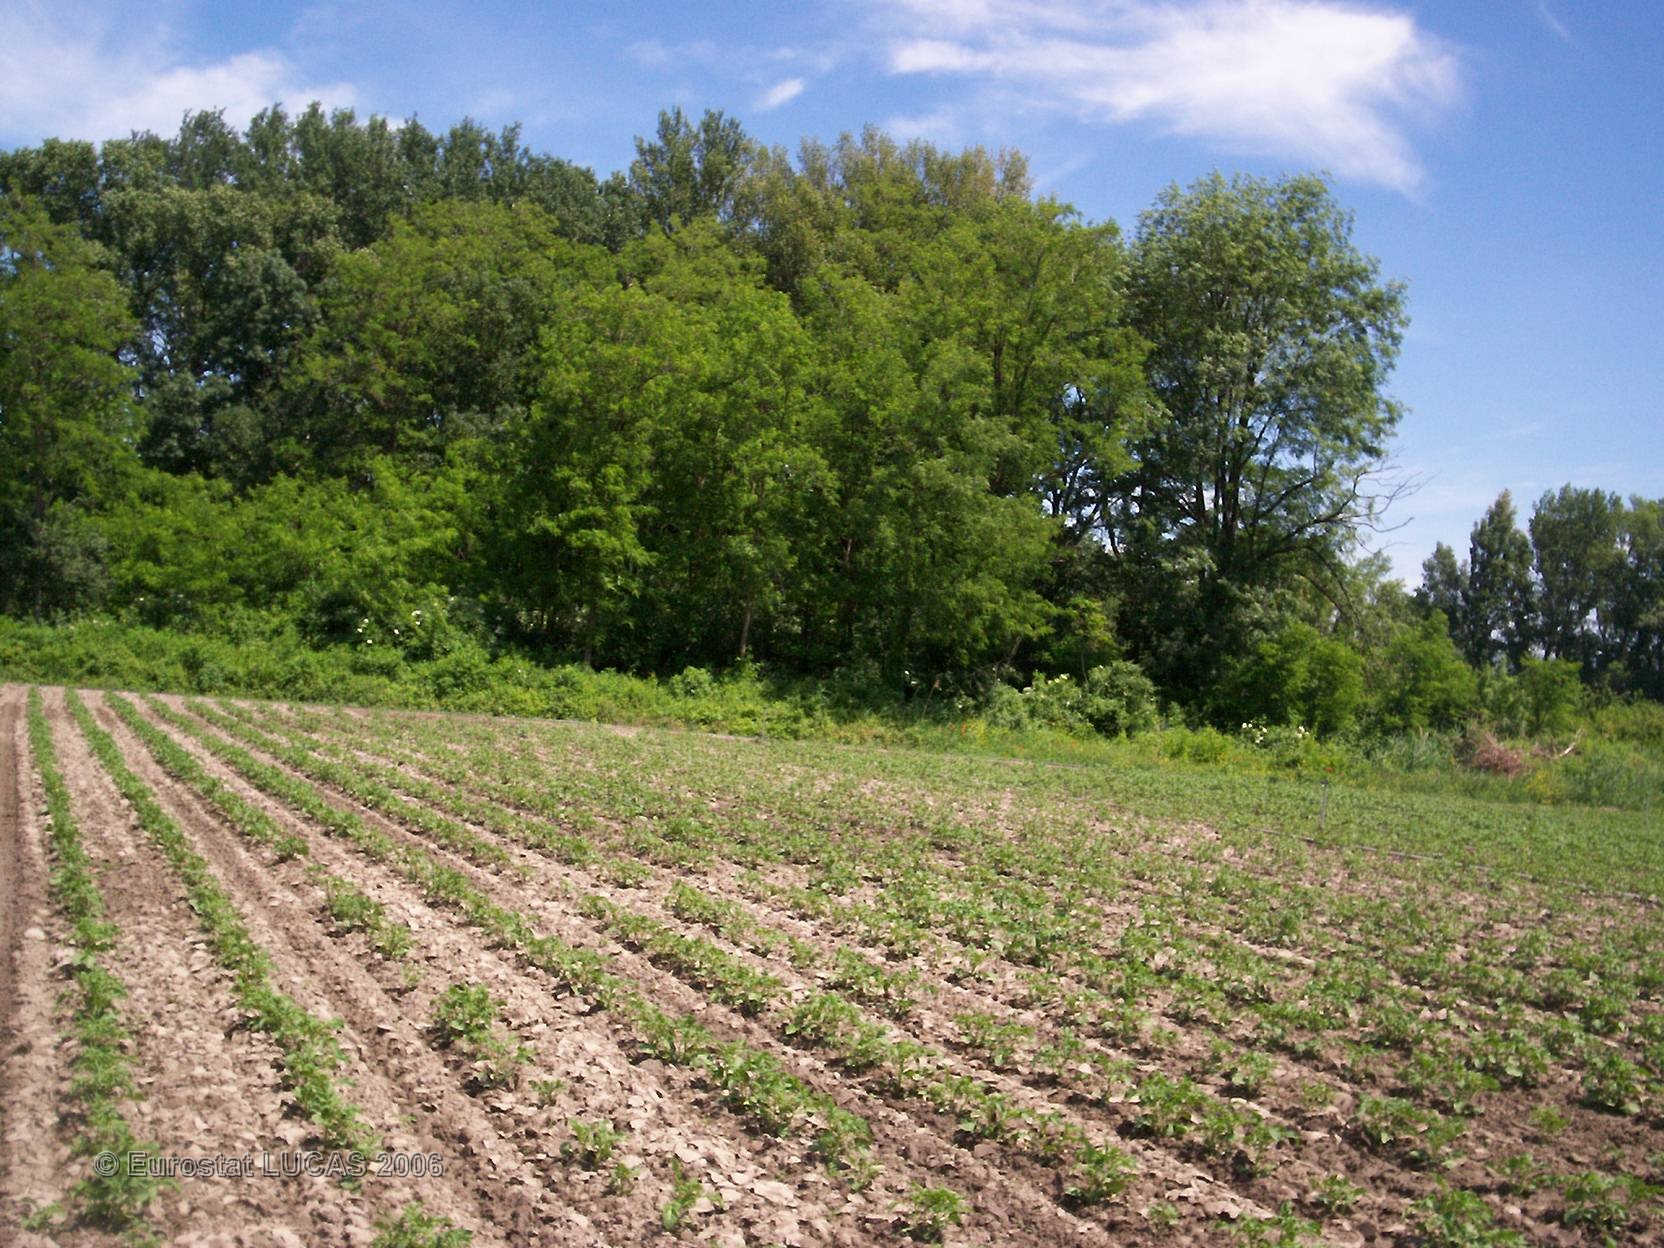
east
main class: Cropland
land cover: Potatoes
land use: Agriculture (excluding fallow land and kitchen gardens)
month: May
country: FR
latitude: 44.8733
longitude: 4.8541
